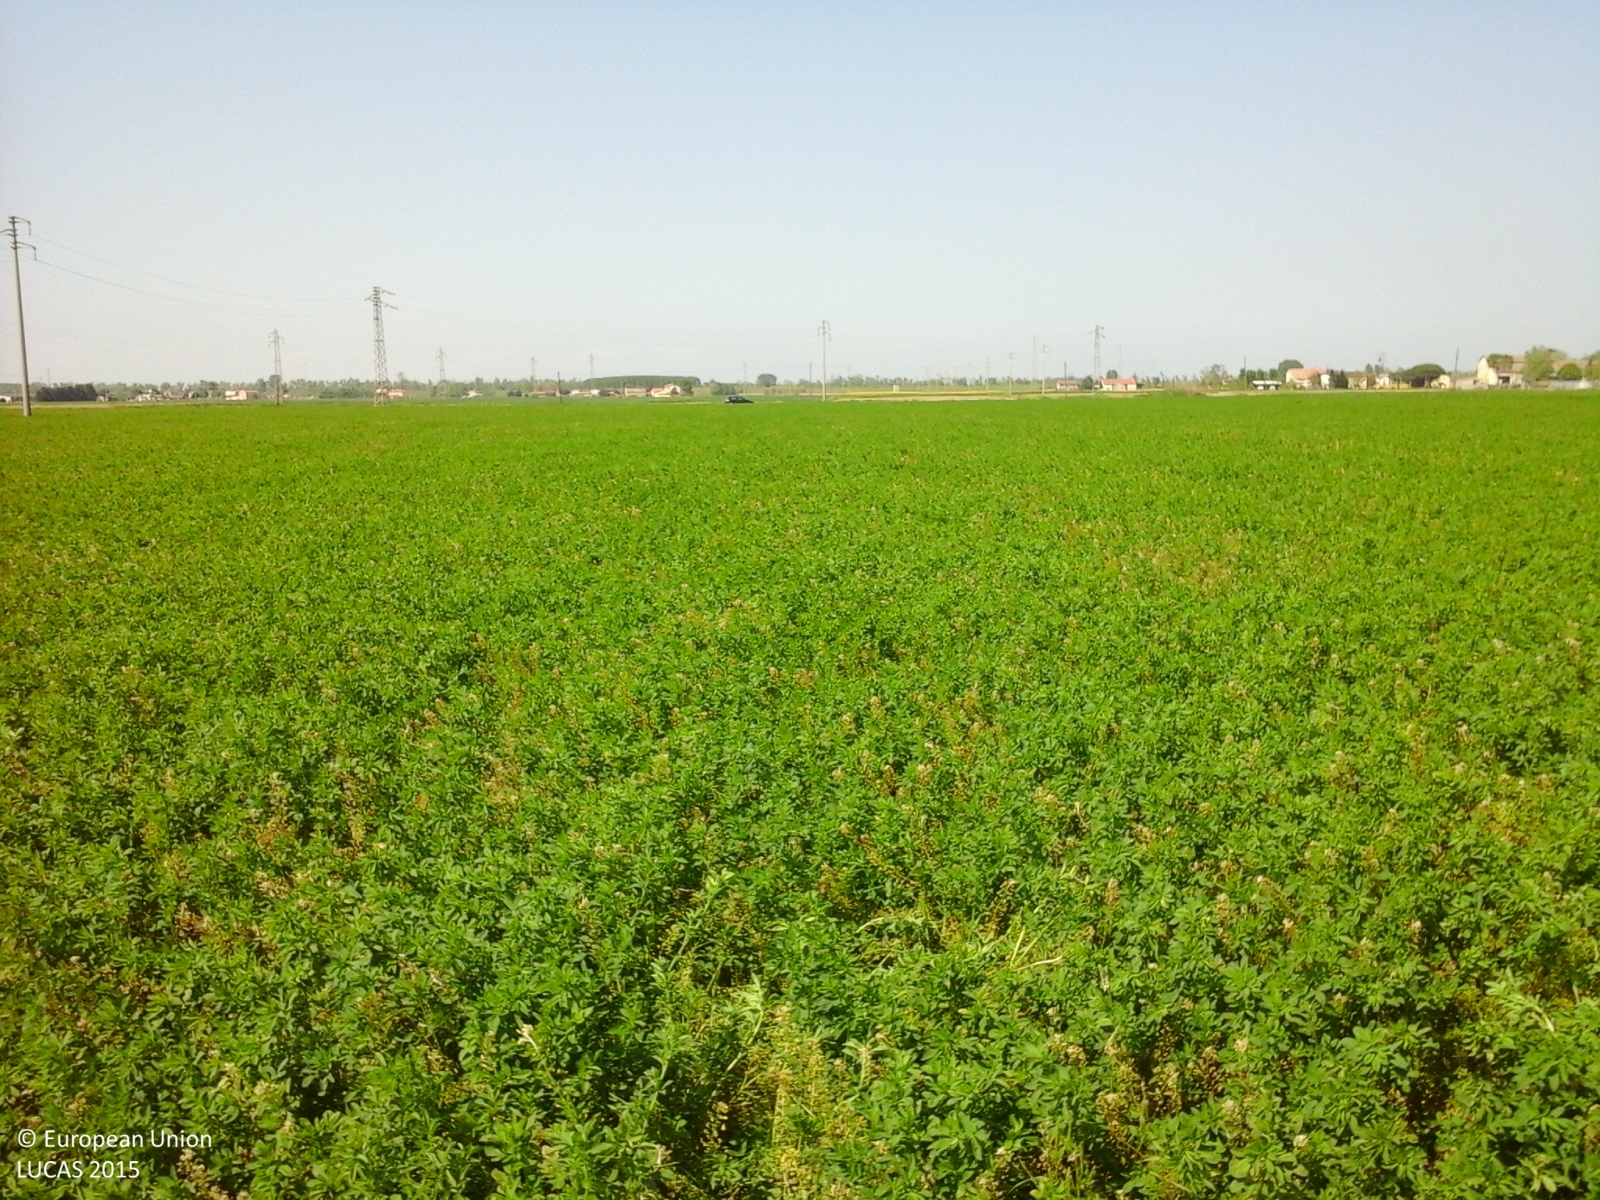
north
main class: Cropland
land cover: Lucerne
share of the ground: > 75 %
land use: Agriculture (excluding fallow land and kitchen gardens)
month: April
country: IT
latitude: 44.9201
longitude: 12.3140
